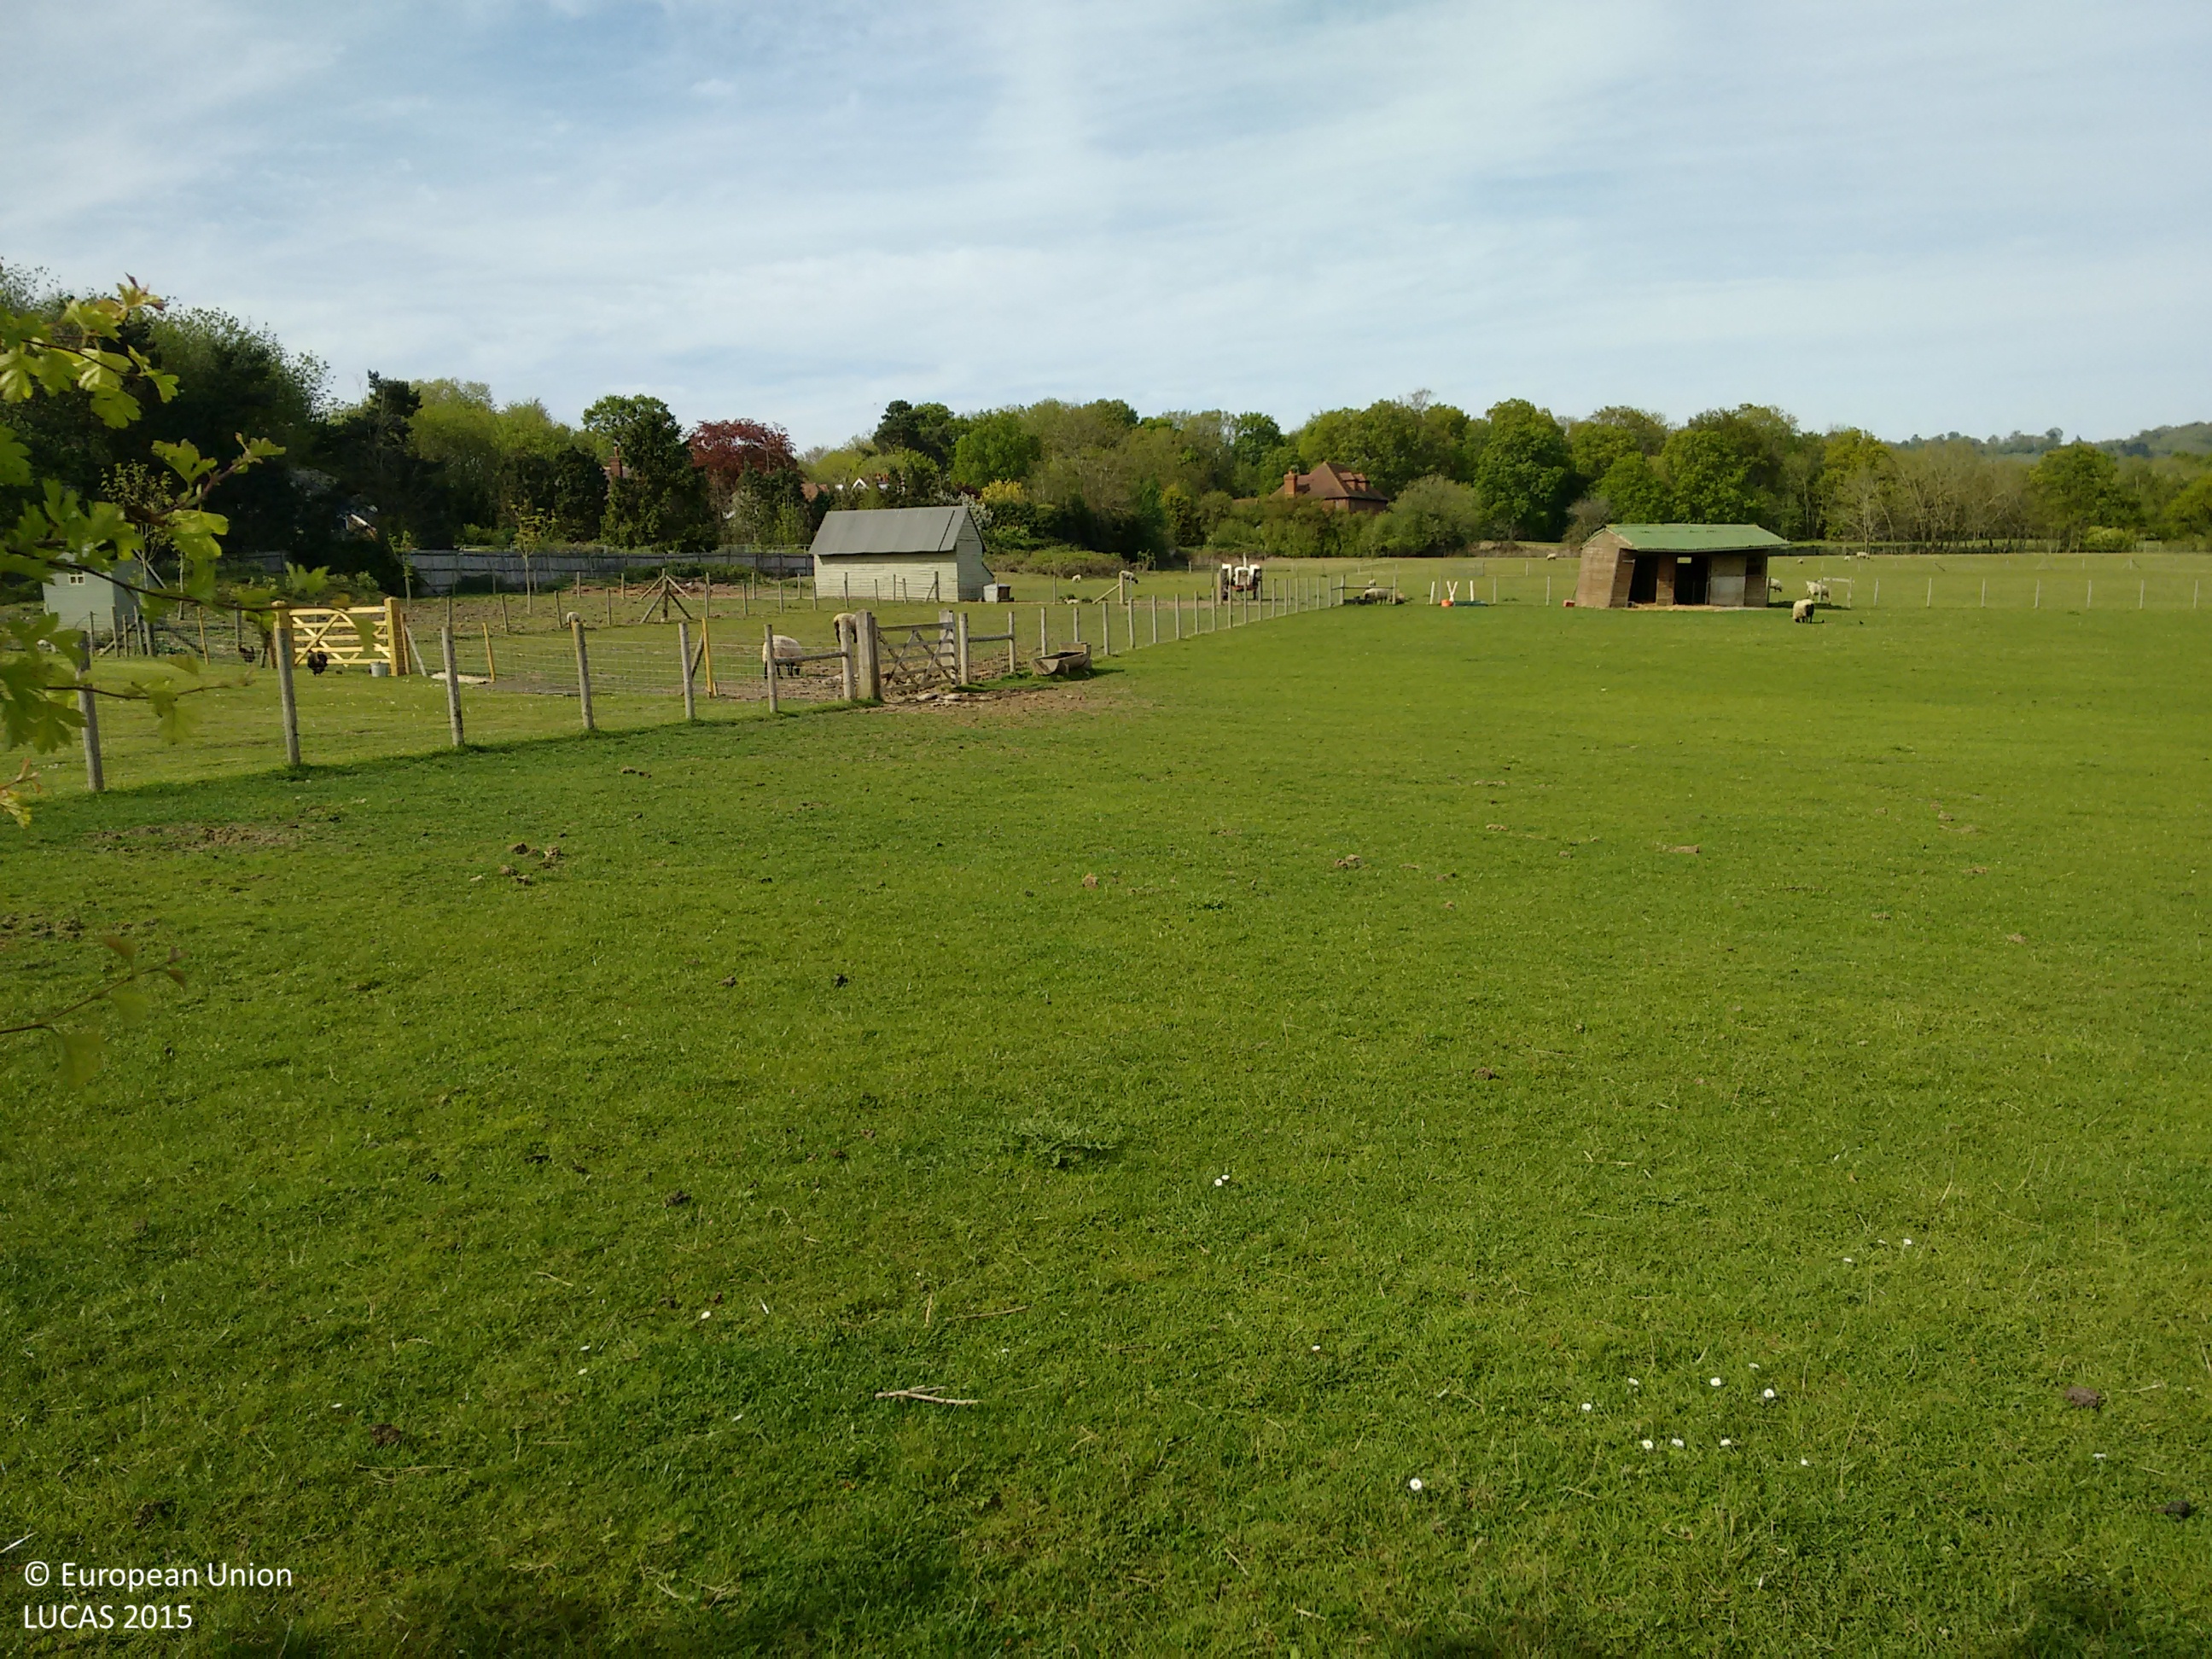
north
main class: Grassland
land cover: Grassland without tree/shrub cover
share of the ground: > 75 %
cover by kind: herbaceous plants 100 %
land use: Agriculture (excluding fallow land and kitchen gardens)
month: May
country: GB
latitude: 51.2783
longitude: 0.5829
